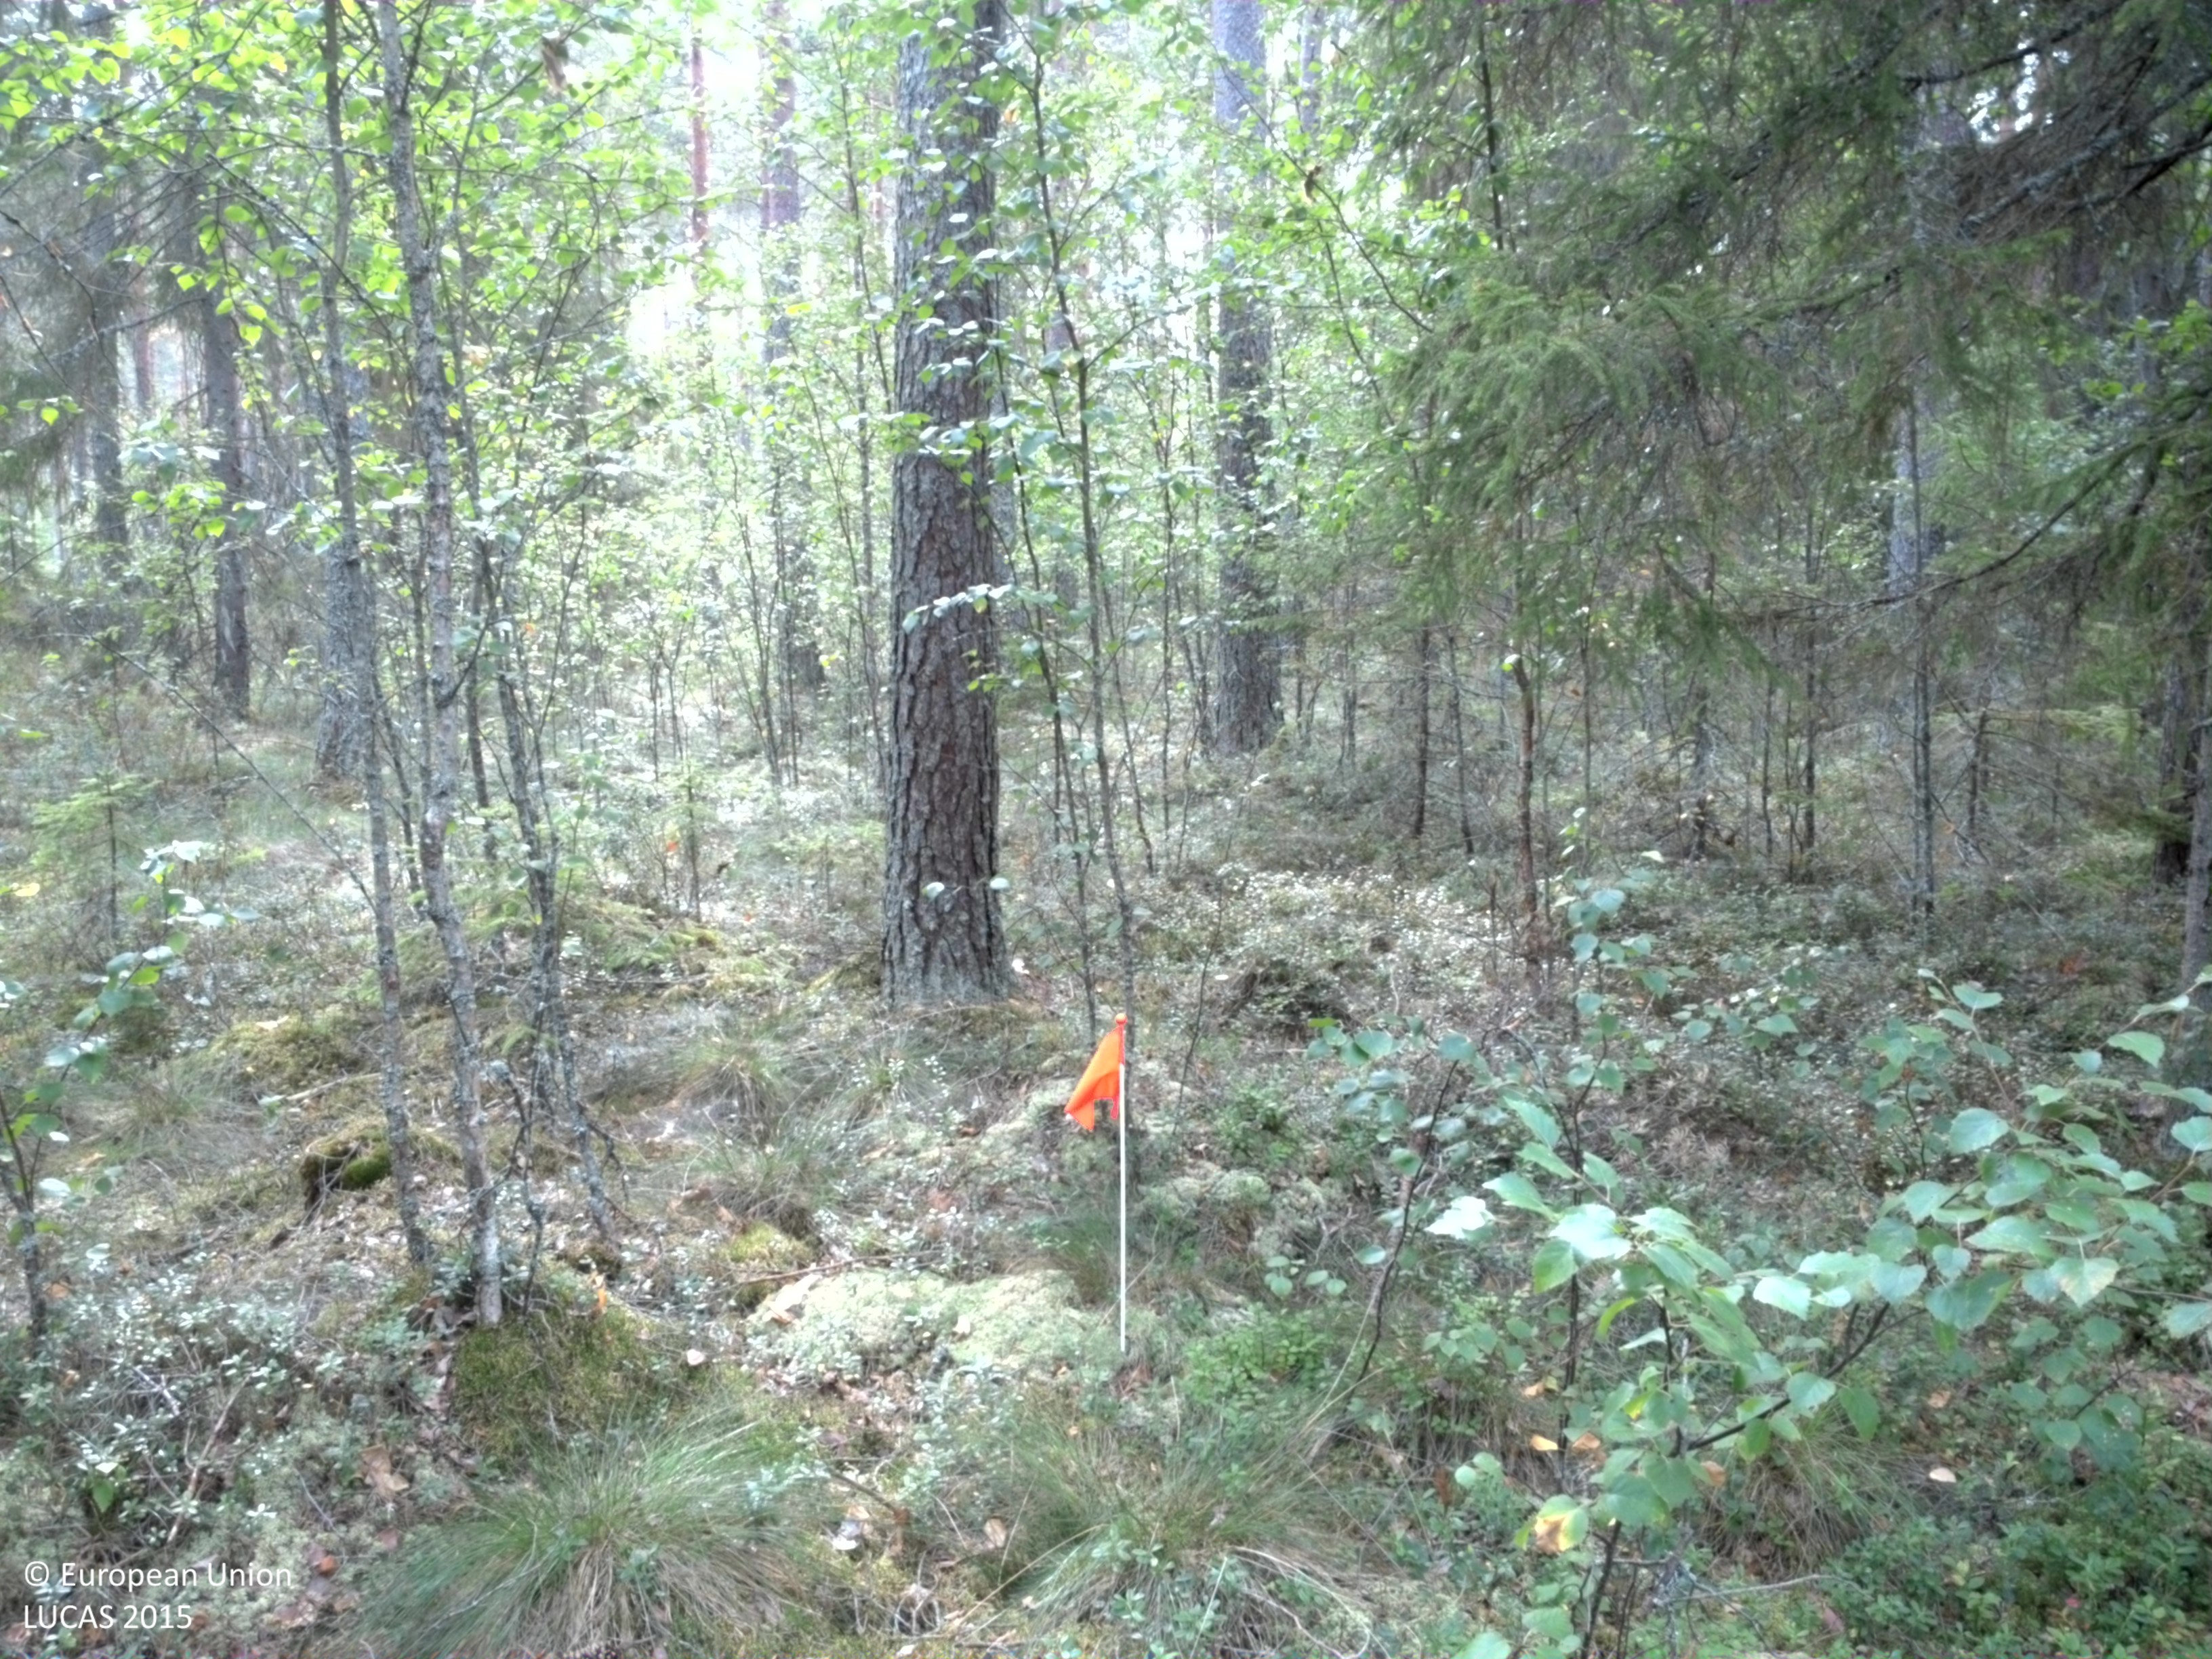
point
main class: Woodland
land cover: Pine dominated mixed woodland
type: boreal forest
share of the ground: 50 - 75 %
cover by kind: coniferous forest trees 40 %, broadleaved forest trees 25 %, shrubs 20 %, lichens and mosses 10 %, herbaceous plants 5 %
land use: Forestry
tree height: > 5 m
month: August
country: SE
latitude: 59.8883
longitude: 15.6189
